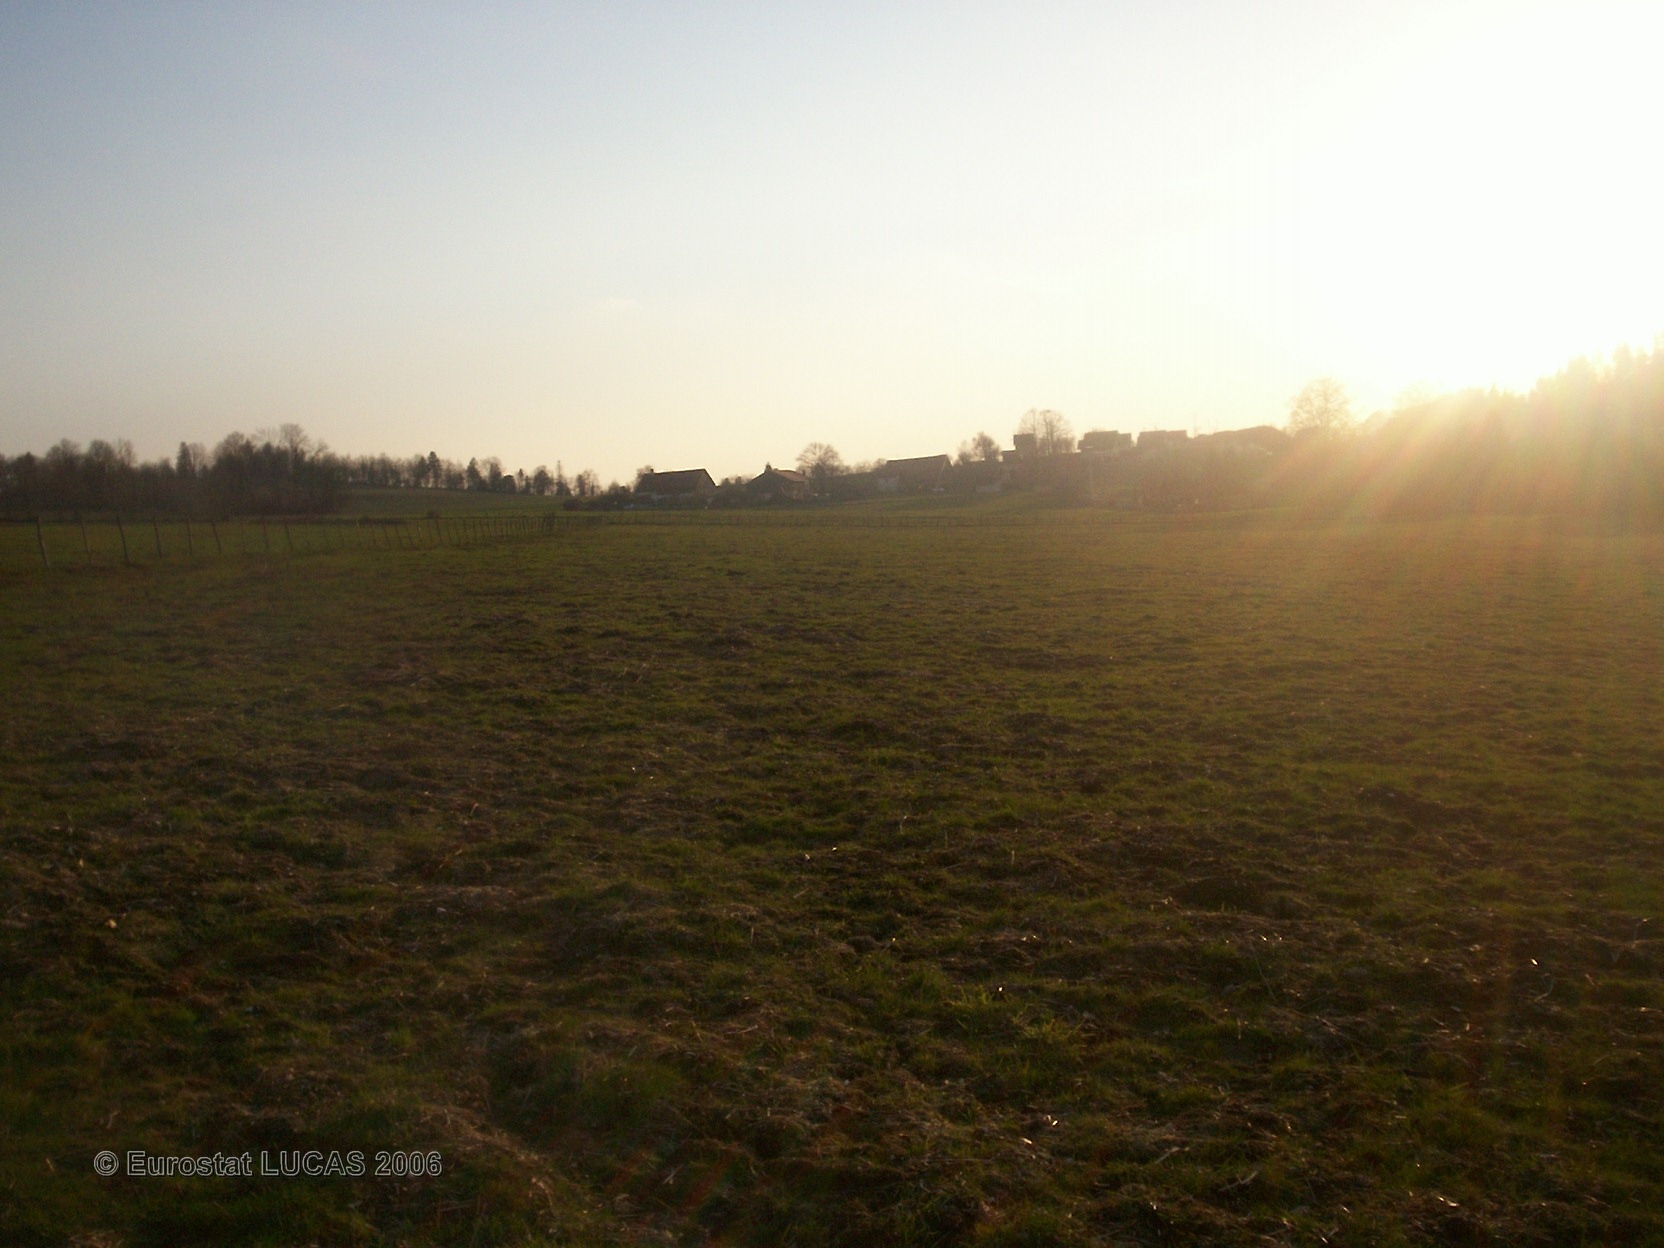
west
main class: Grassland
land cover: Grassland without tree/shrub cover
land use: Agriculture (excluding fallow land and kitchen gardens)
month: April
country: FR
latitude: 47.2800
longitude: 6.9217
